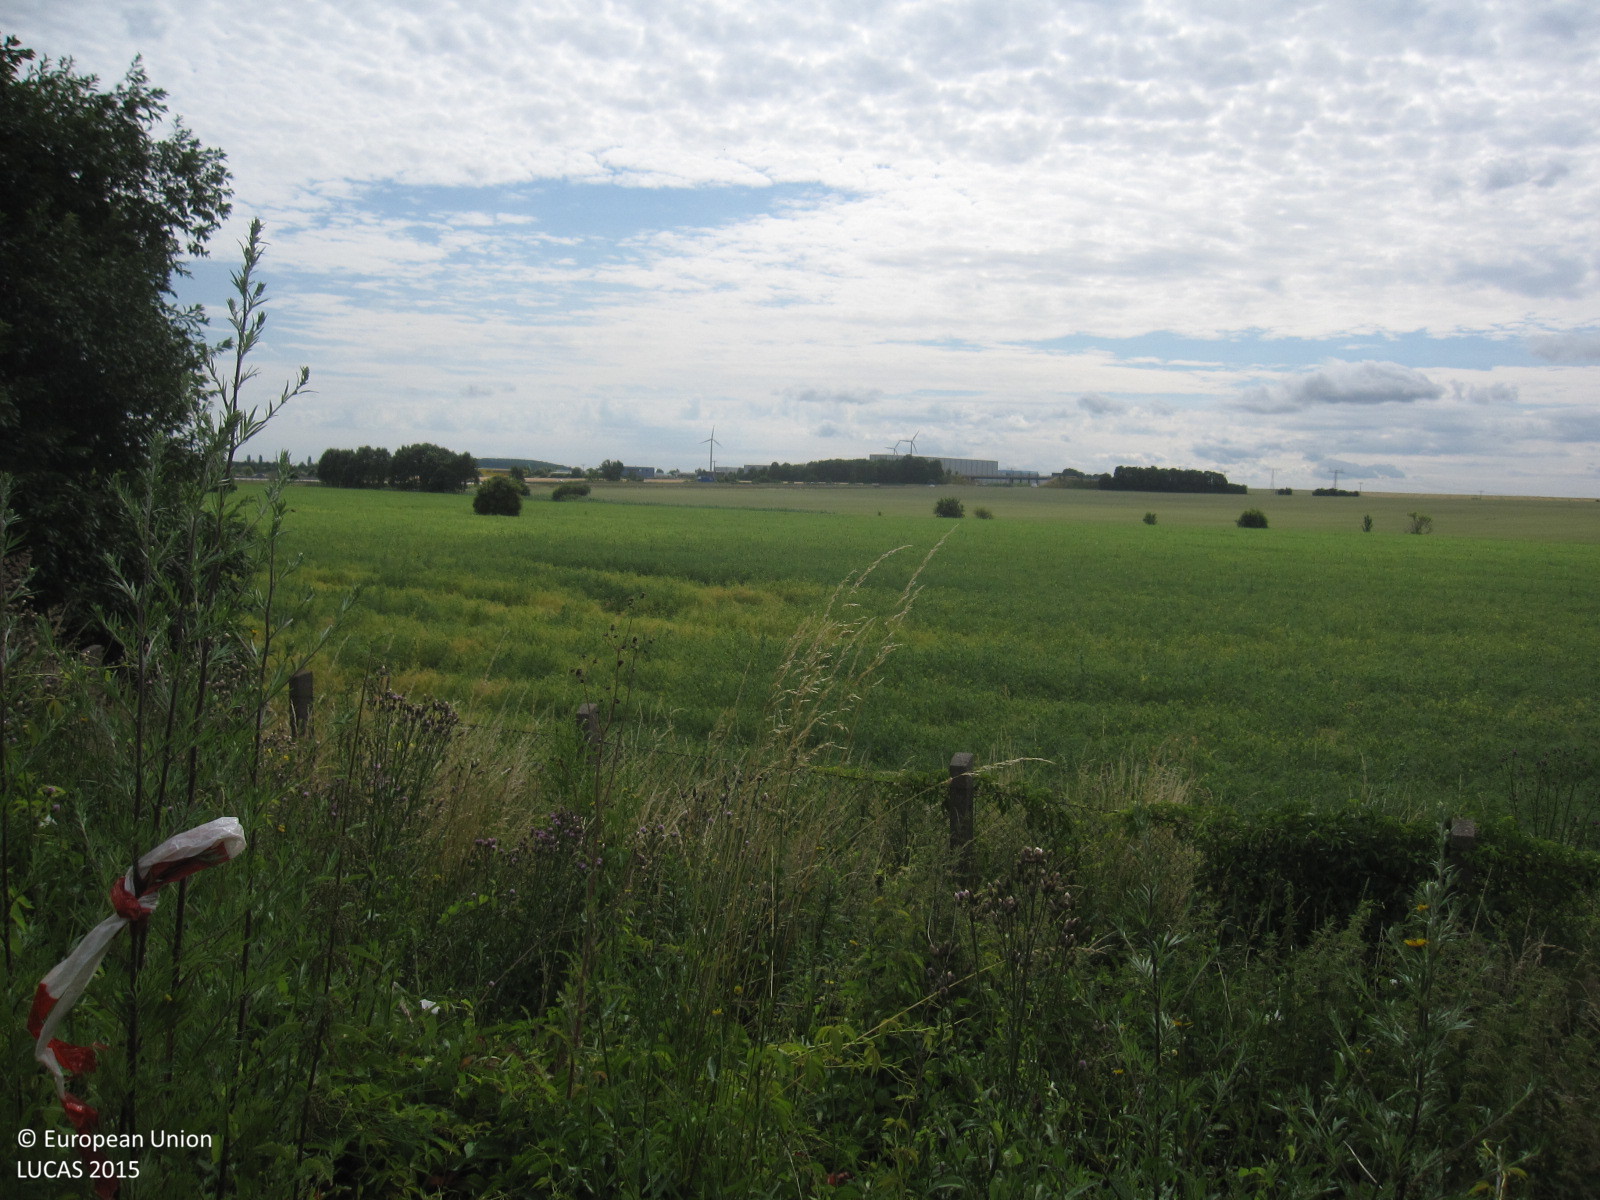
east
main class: Grassland
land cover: Spontaneously vegetated surfaces
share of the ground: > 75 %
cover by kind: herbaceous plants 90 %, consolidated bare surface 10 %
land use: Abandoned areas
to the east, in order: Spontaneously vegetated surfaces; Fences; Grass margins; Dry pulses
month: July
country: DE
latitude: 50.8835
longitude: 12.1460
